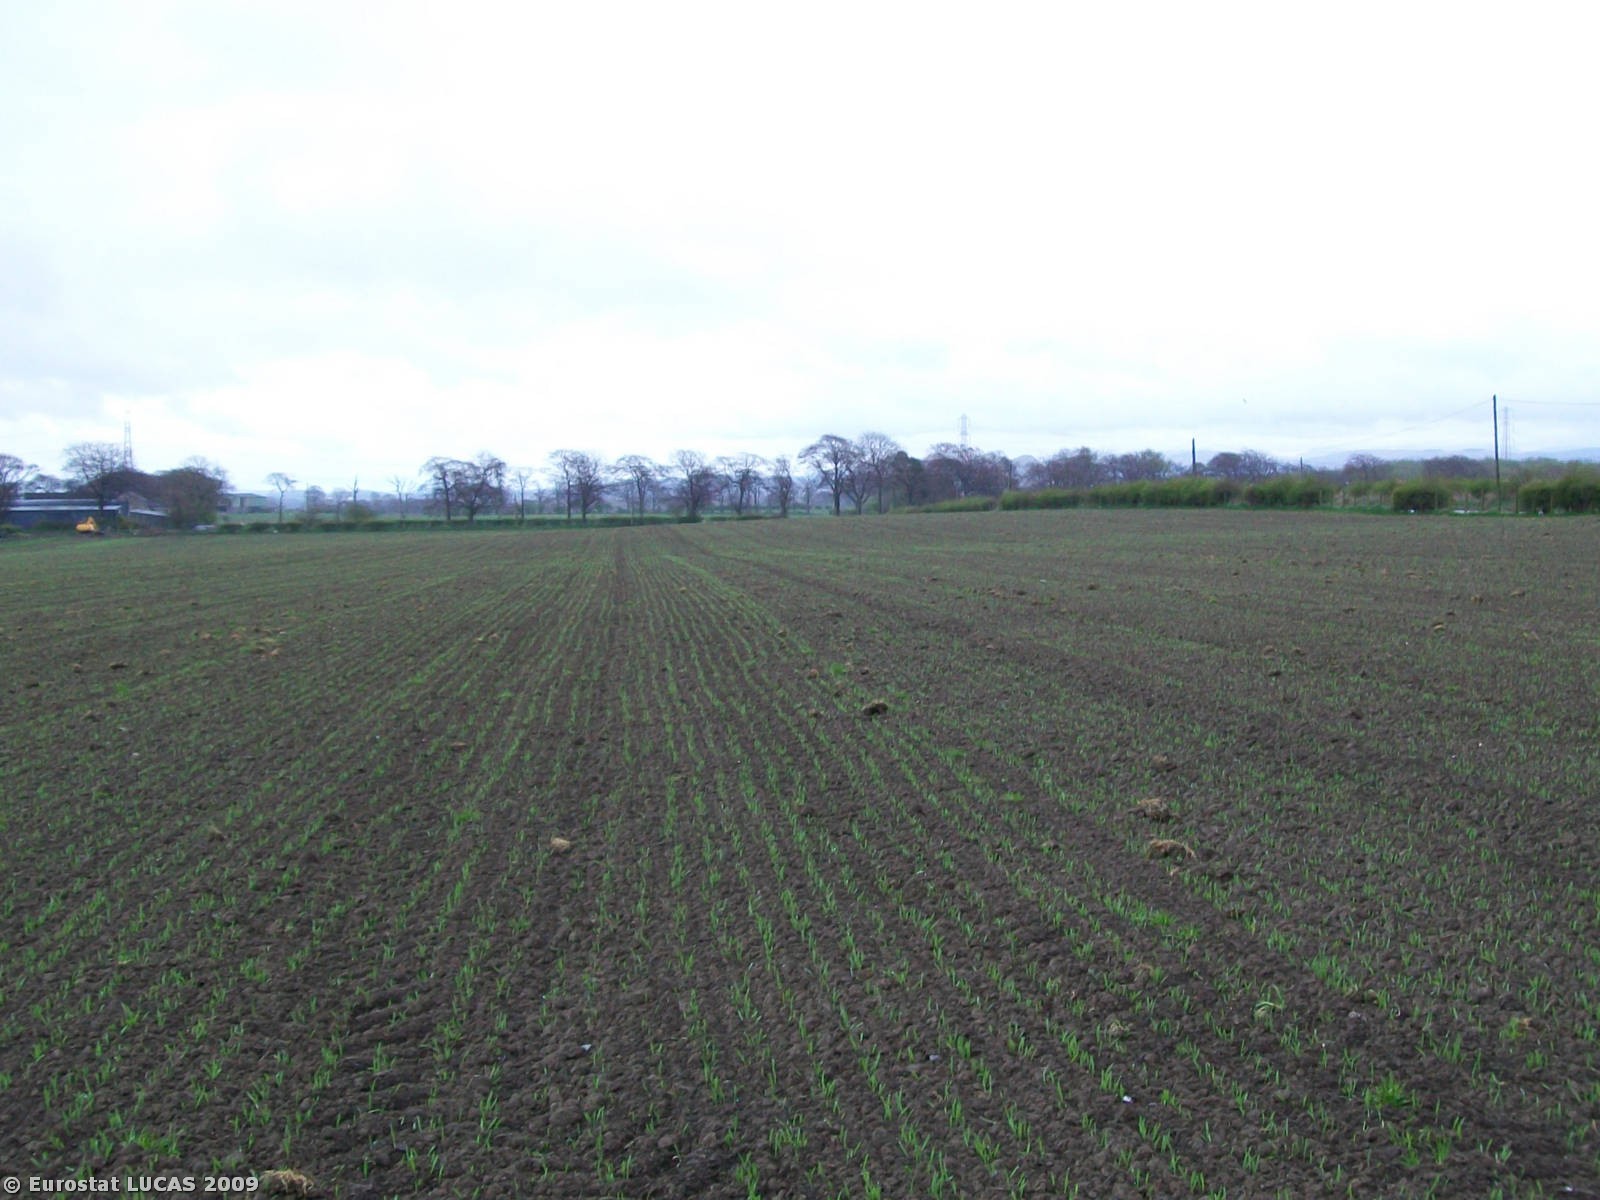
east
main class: Cropland
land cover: Barley
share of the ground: > 75 %
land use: Agriculture (excluding fallow land and kitchen gardens)
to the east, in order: Barley
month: April
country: GB
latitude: 55.8562
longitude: -3.6437
